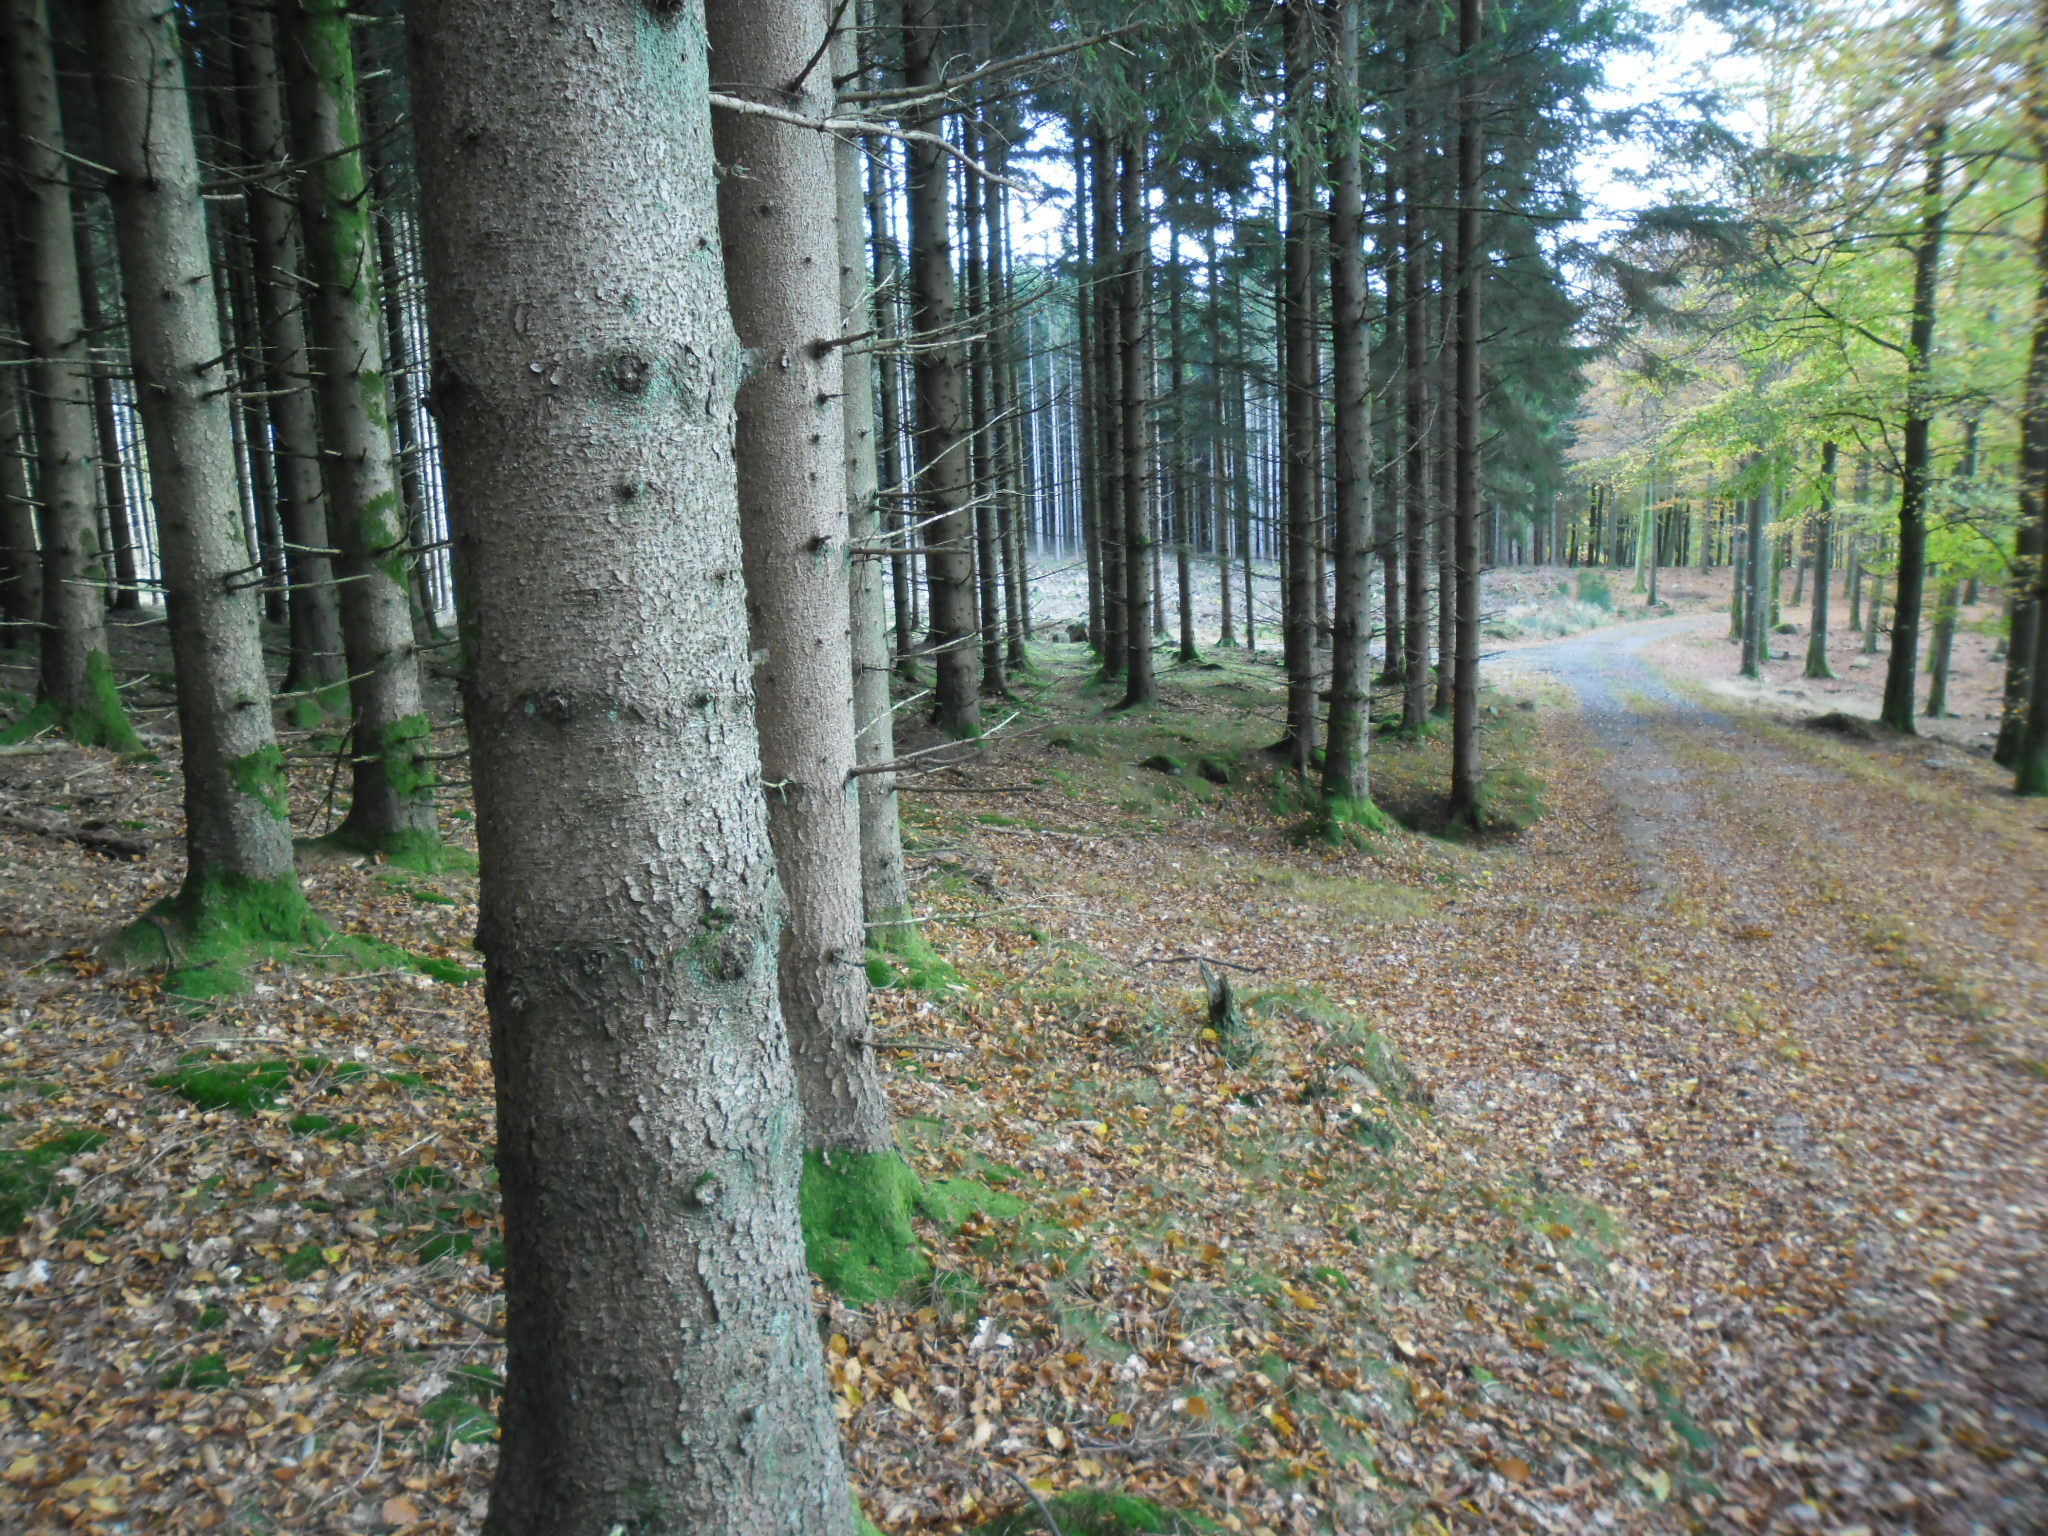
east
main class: Woodland
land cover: Spruce dominated coniferous woodland
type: boreal forest
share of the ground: > 75 %
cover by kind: coniferous forest trees 80 %, lichens and mosses 20 %
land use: Forestry
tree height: > 5 m
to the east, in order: Spruce dominated coniferous woodland; Tracks; Other bare soil; Spruce dominated coniferous woodland
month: October
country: SE
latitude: 56.3298
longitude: 13.1186
